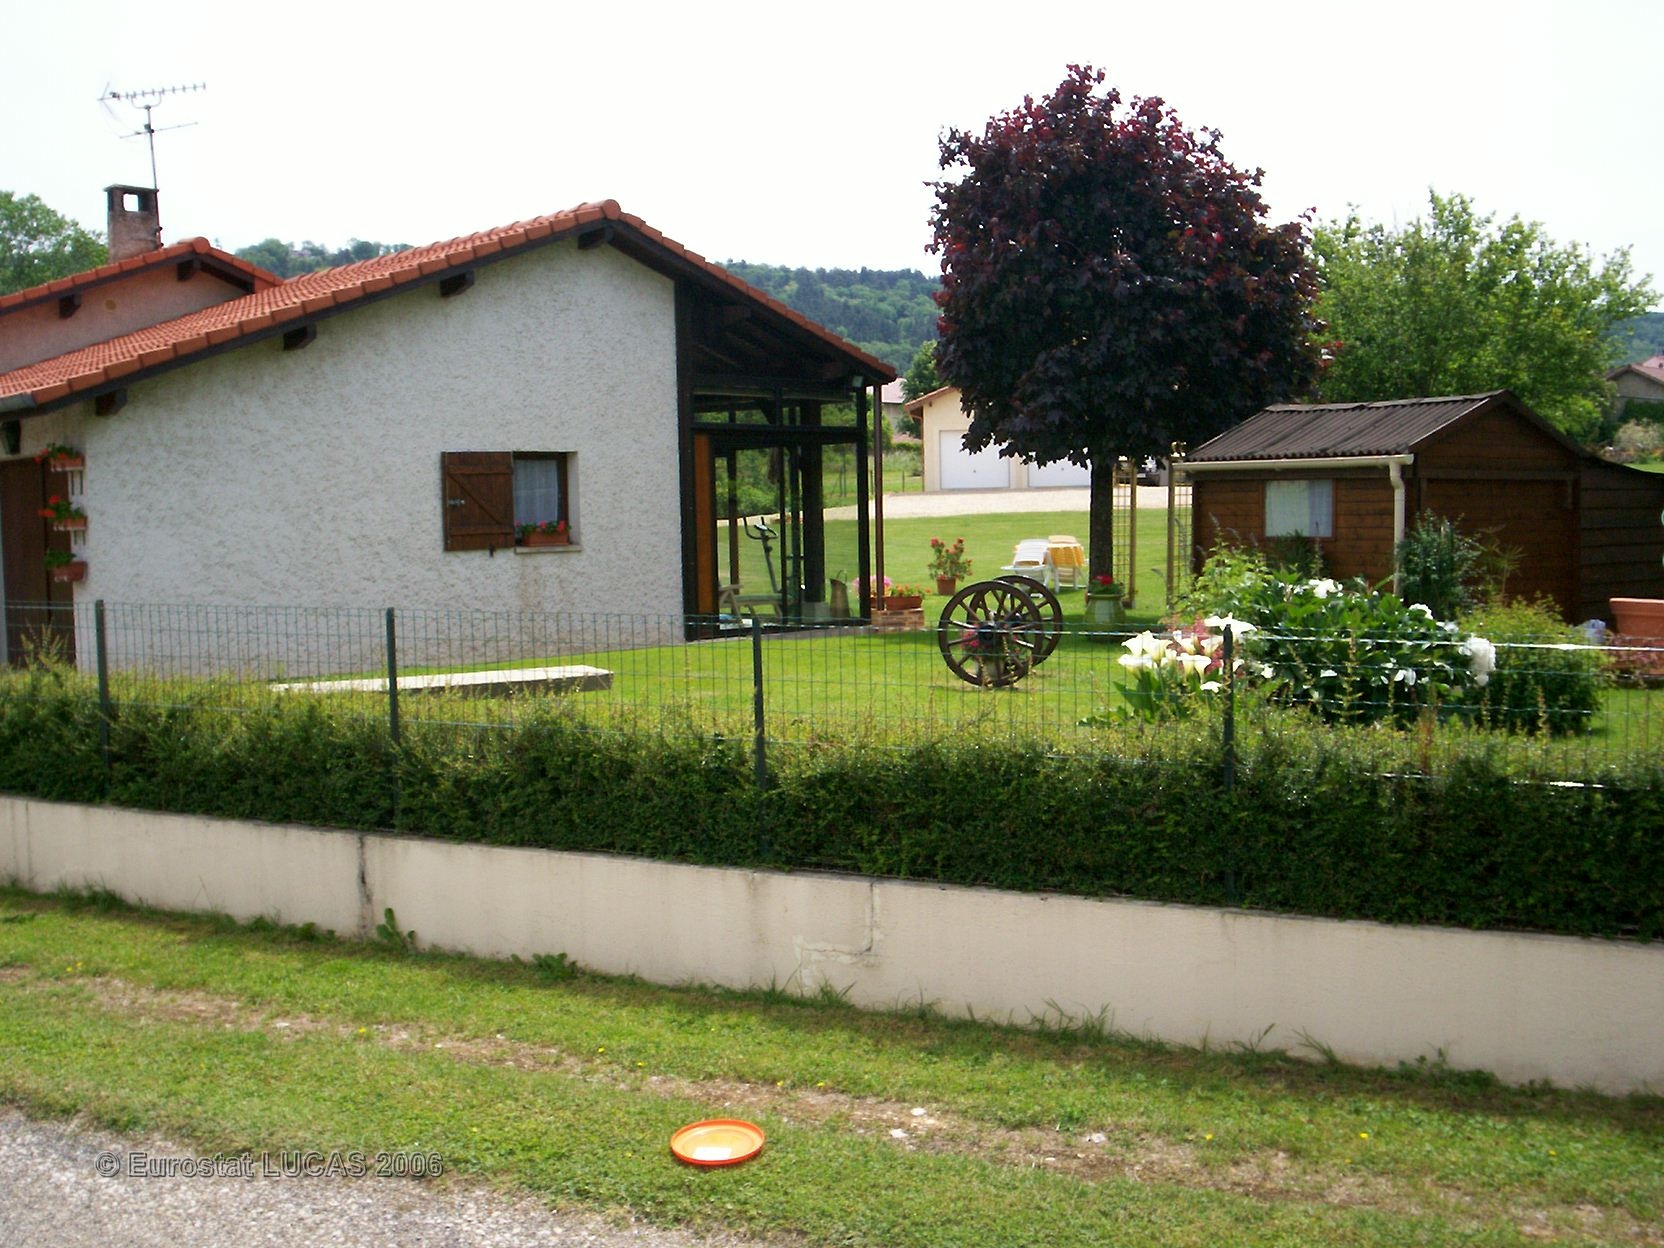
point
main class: Grassland
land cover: Grassland with sparse tree/shrub cover
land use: Residential
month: June
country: FR
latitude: 46.2129
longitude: 5.3237
